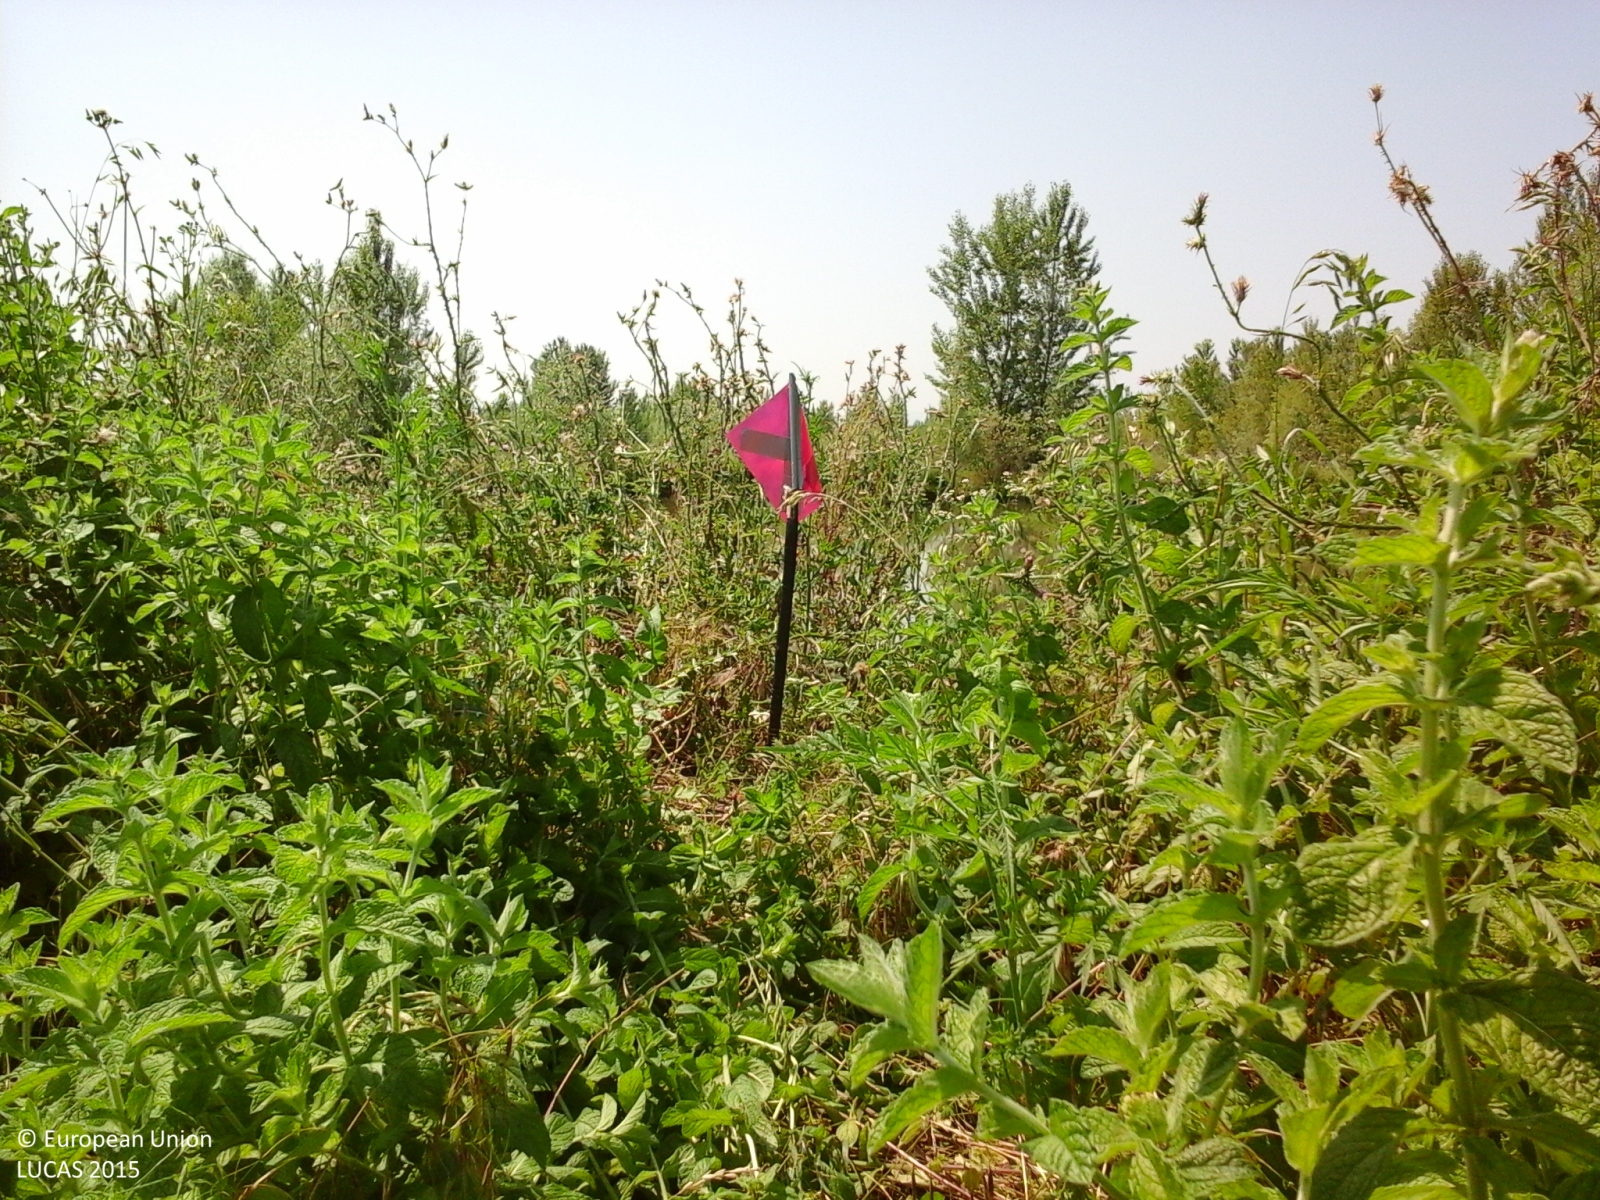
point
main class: Shrubland
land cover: Shrubland with sparse tree cover
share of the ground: > 75 %
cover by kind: shrubs 60 %, herbaceous plants 35 %, broadleaved forest trees 5 %
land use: Semi-natural and natural areas not in use
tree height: < 5 m
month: June
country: IT
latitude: 44.5962
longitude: 11.1942
